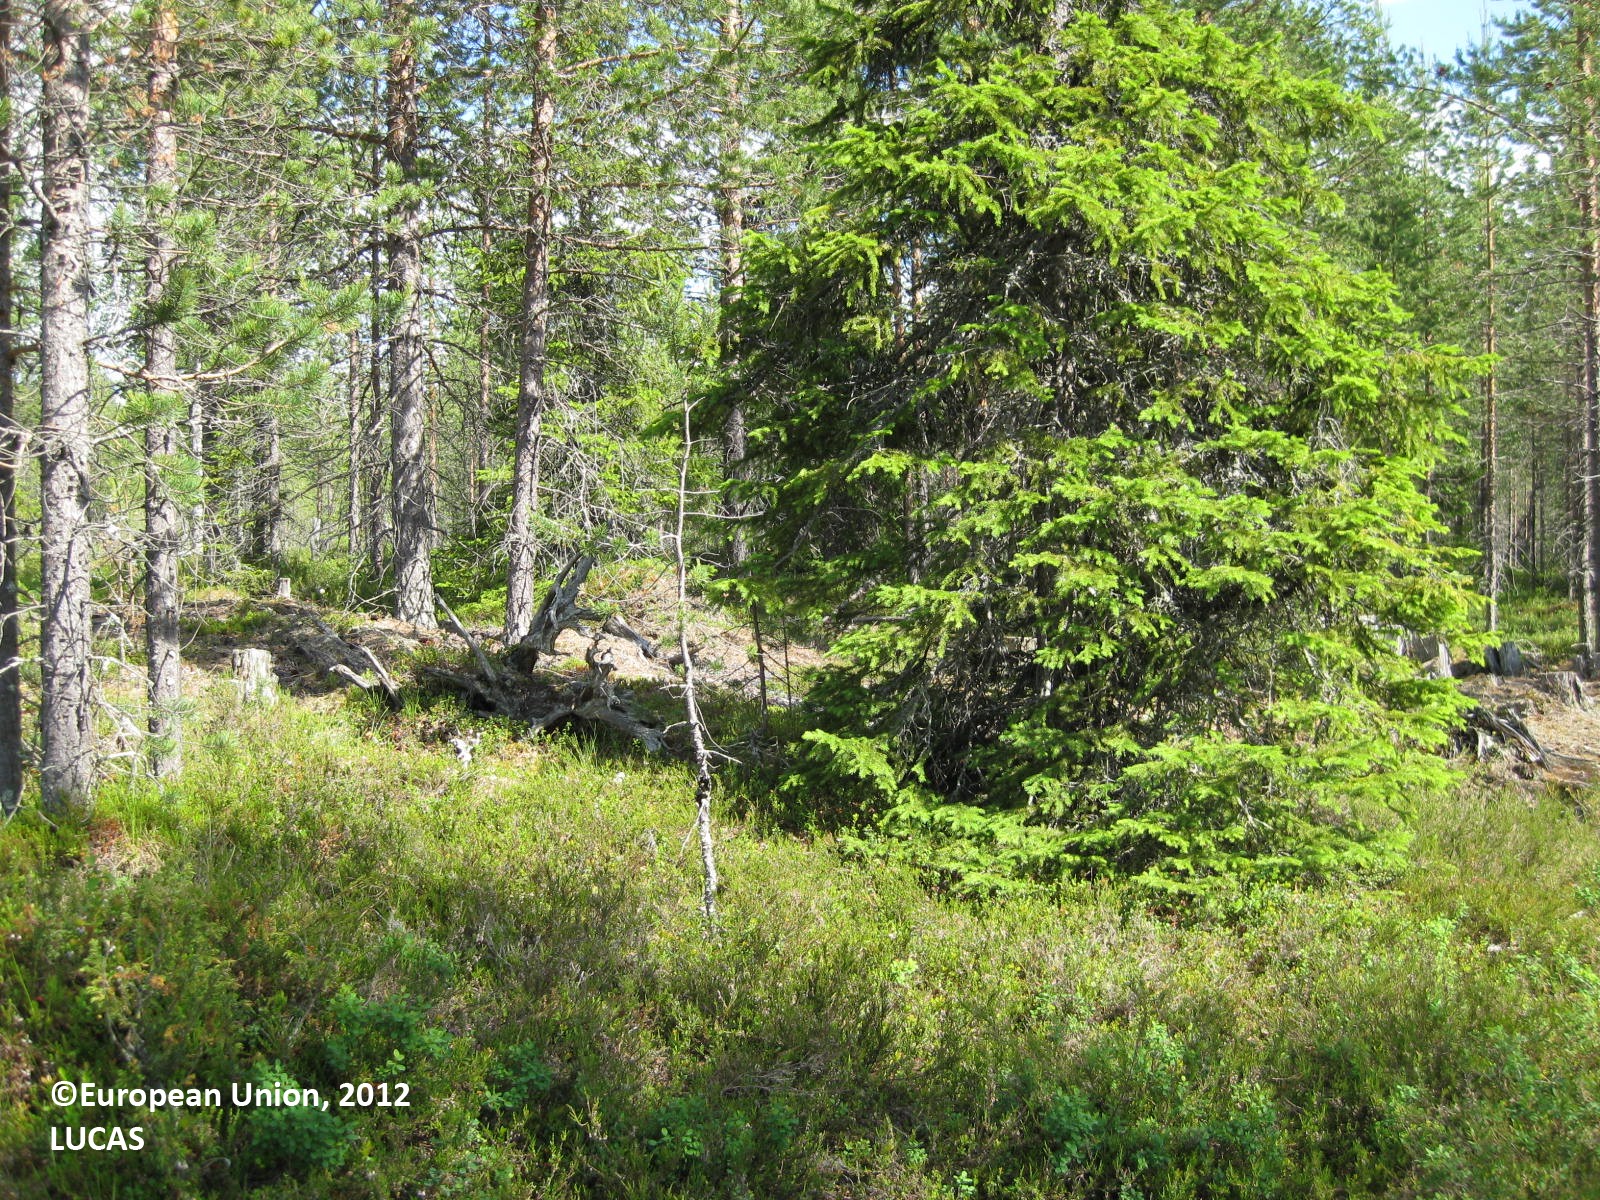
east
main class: Woodland
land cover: Pine dominated coniferous woodland
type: boreal forest
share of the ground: 50 - 75 %
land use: Forestry
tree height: > 5 m
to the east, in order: Pine dominated coniferous woodland; Other coniferous woodland; Pine dominated coniferous woodland
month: July
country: FI
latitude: 65.5223
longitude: 29.4238
